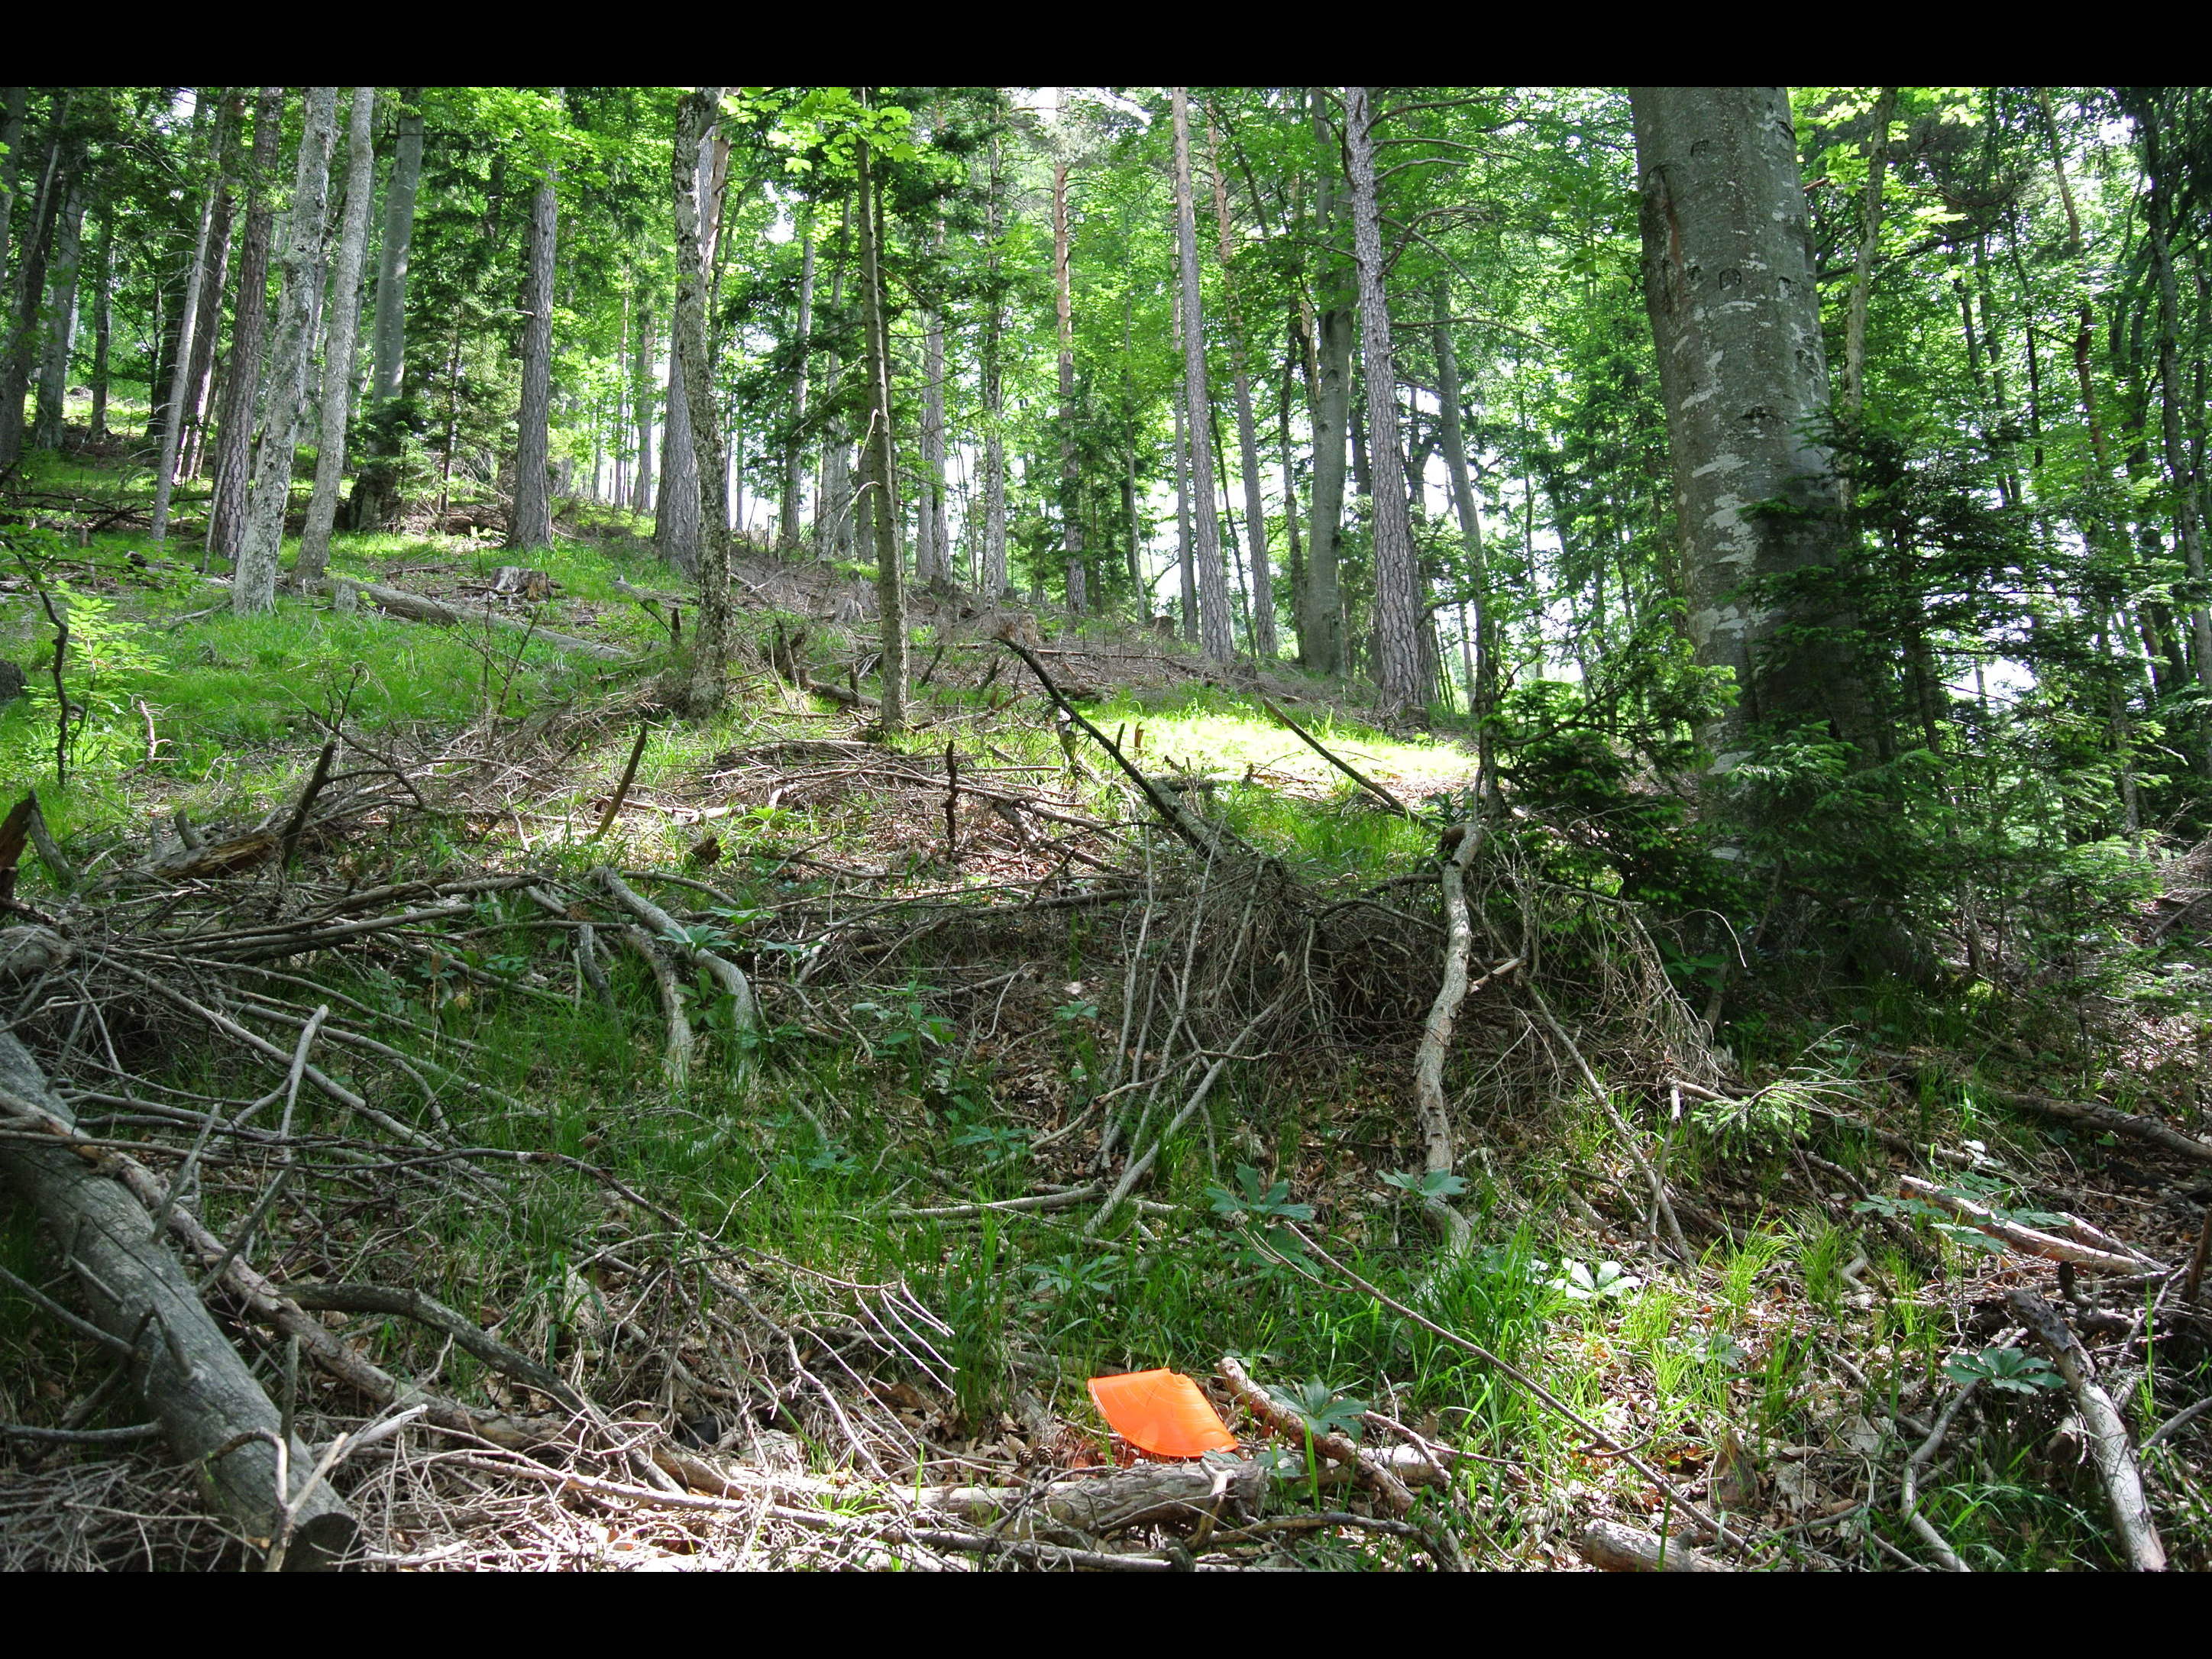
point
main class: Woodland
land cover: Other mixed woodland
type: alpine coniferous forest
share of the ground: > 75 %
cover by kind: broadleaved forest trees 70 %, coniferous forest trees 30 %
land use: Forestry
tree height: > 5 m
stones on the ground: < 10 %
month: June
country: AT
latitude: 47.9115
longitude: 15.7423
